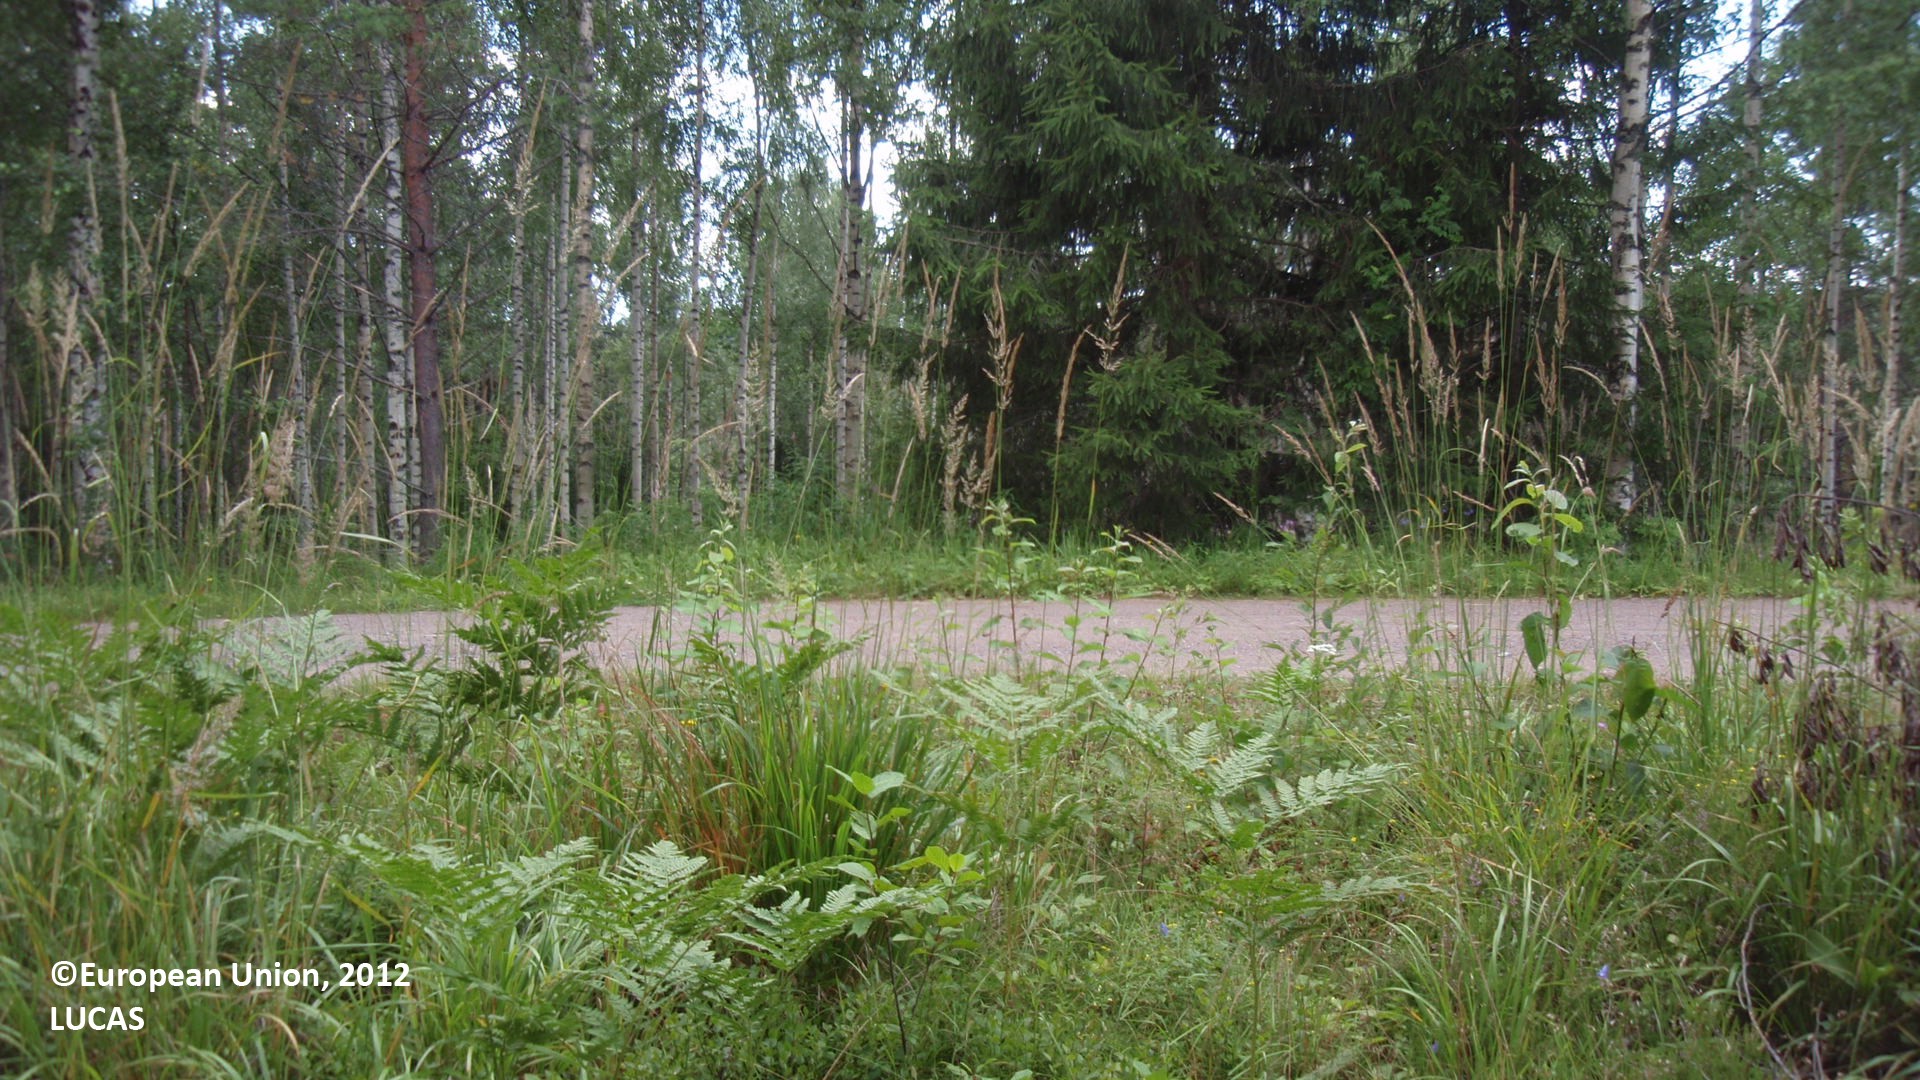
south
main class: Woodland
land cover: Spruce dominated mixed woodland
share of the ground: 50 - 75 %
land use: Forestry
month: July
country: FI
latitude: 61.3796
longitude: 28.8858
